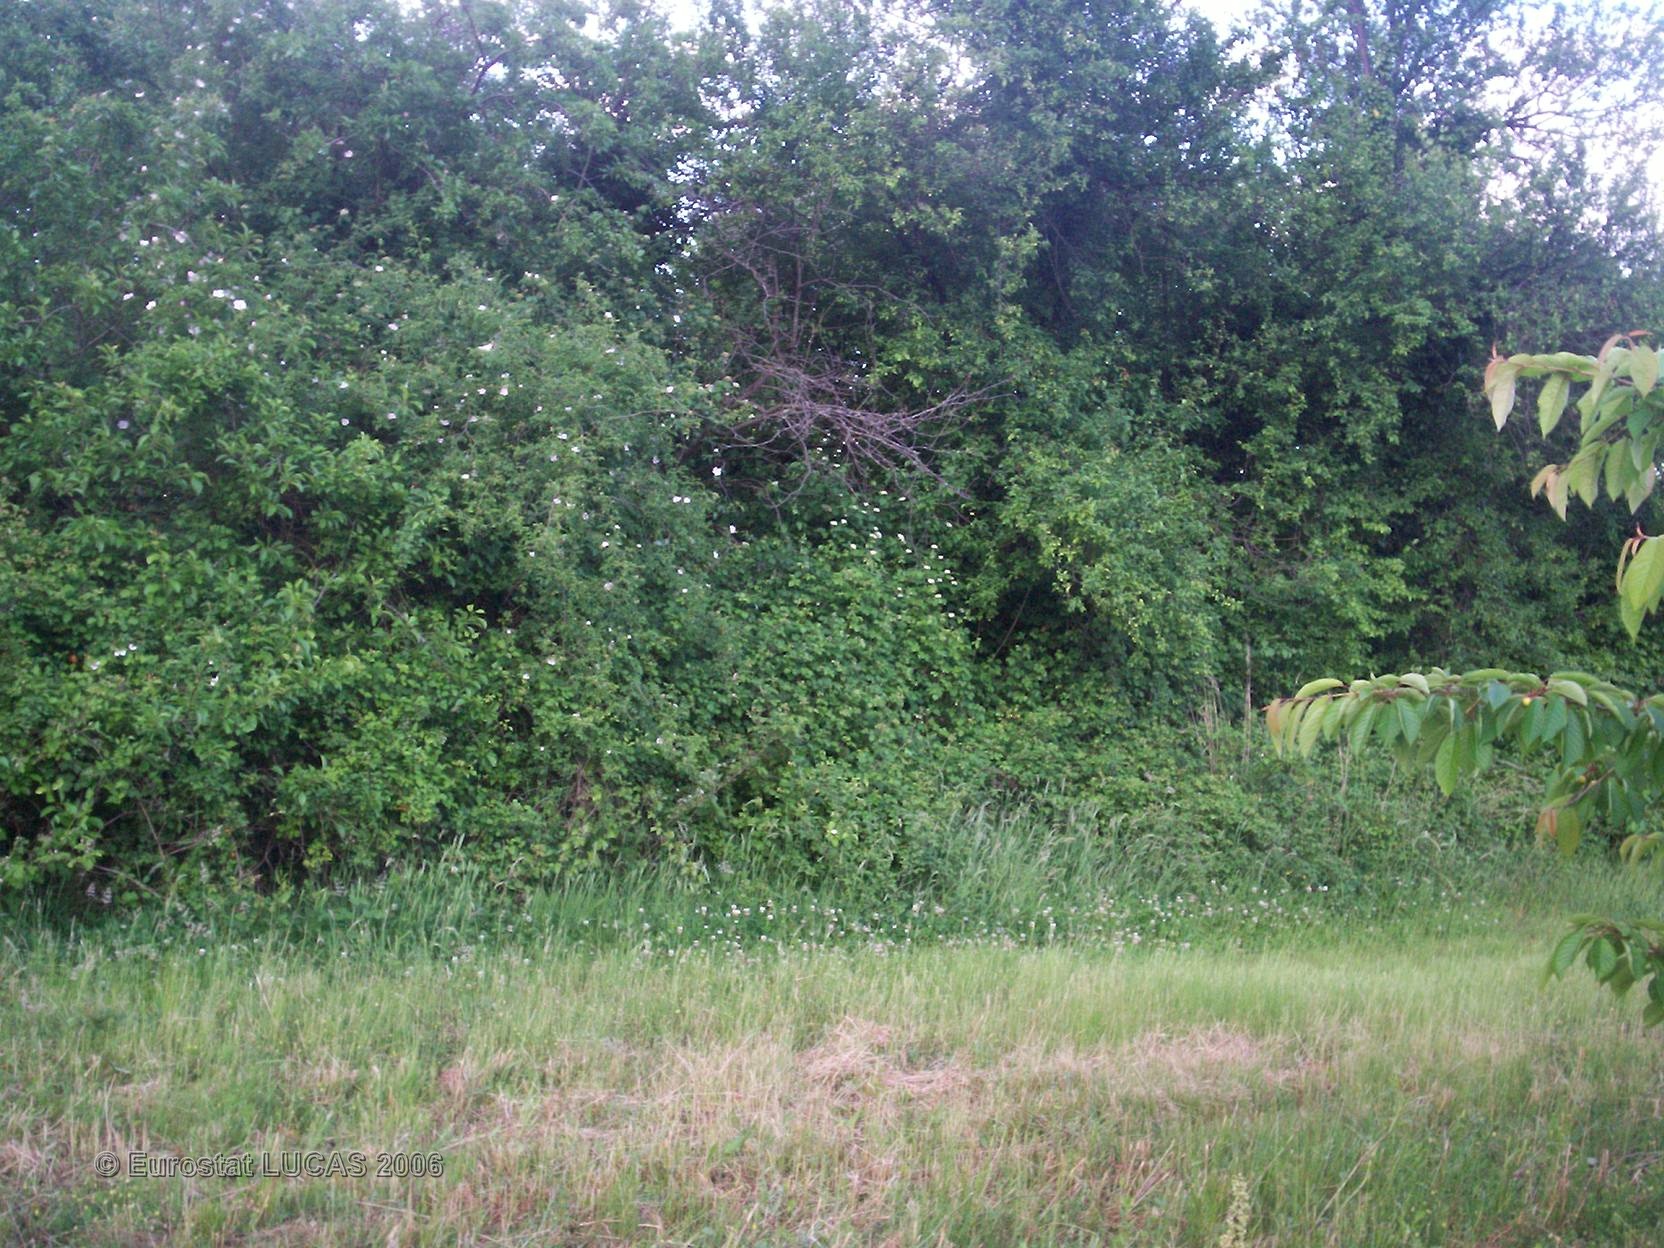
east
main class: Cropland
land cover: Cherry fruit
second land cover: Grassland with sparse tree/shrub cover
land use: Agriculture (excluding fallow land and kitchen gardens)
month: May
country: FR
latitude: 45.3561
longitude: 4.7580
